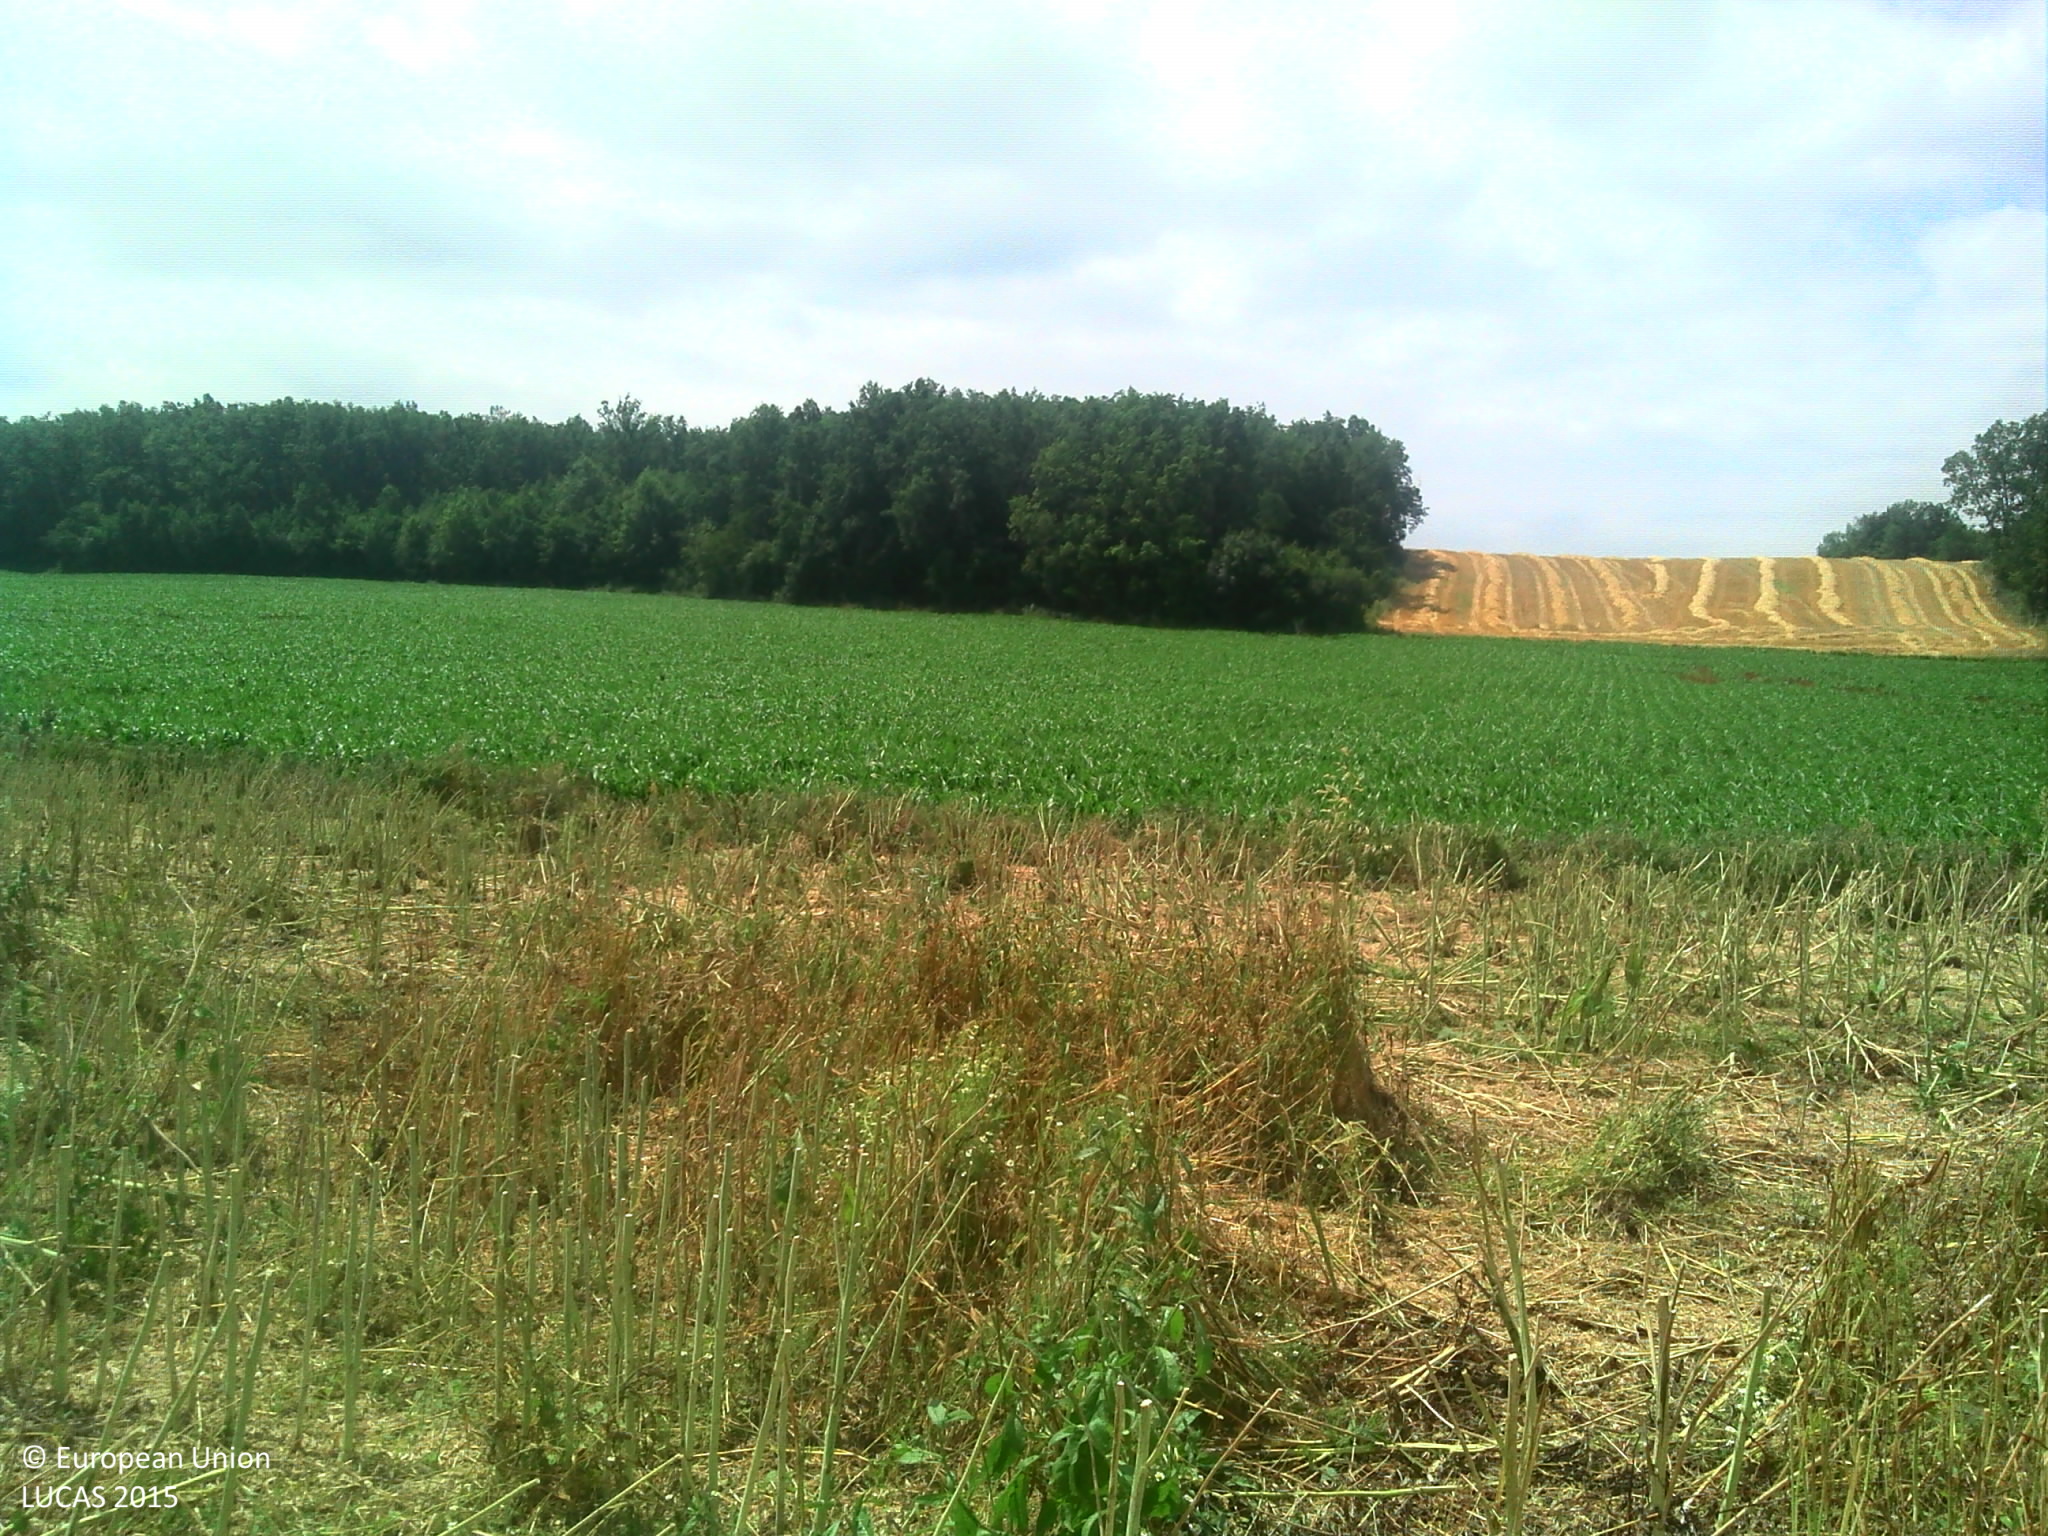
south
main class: Cropland
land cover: Rape and turnip rape
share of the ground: 25 - 50 %
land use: Agriculture (excluding fallow land and kitchen gardens)
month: June
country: FR
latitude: 44.1524
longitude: 0.9323
